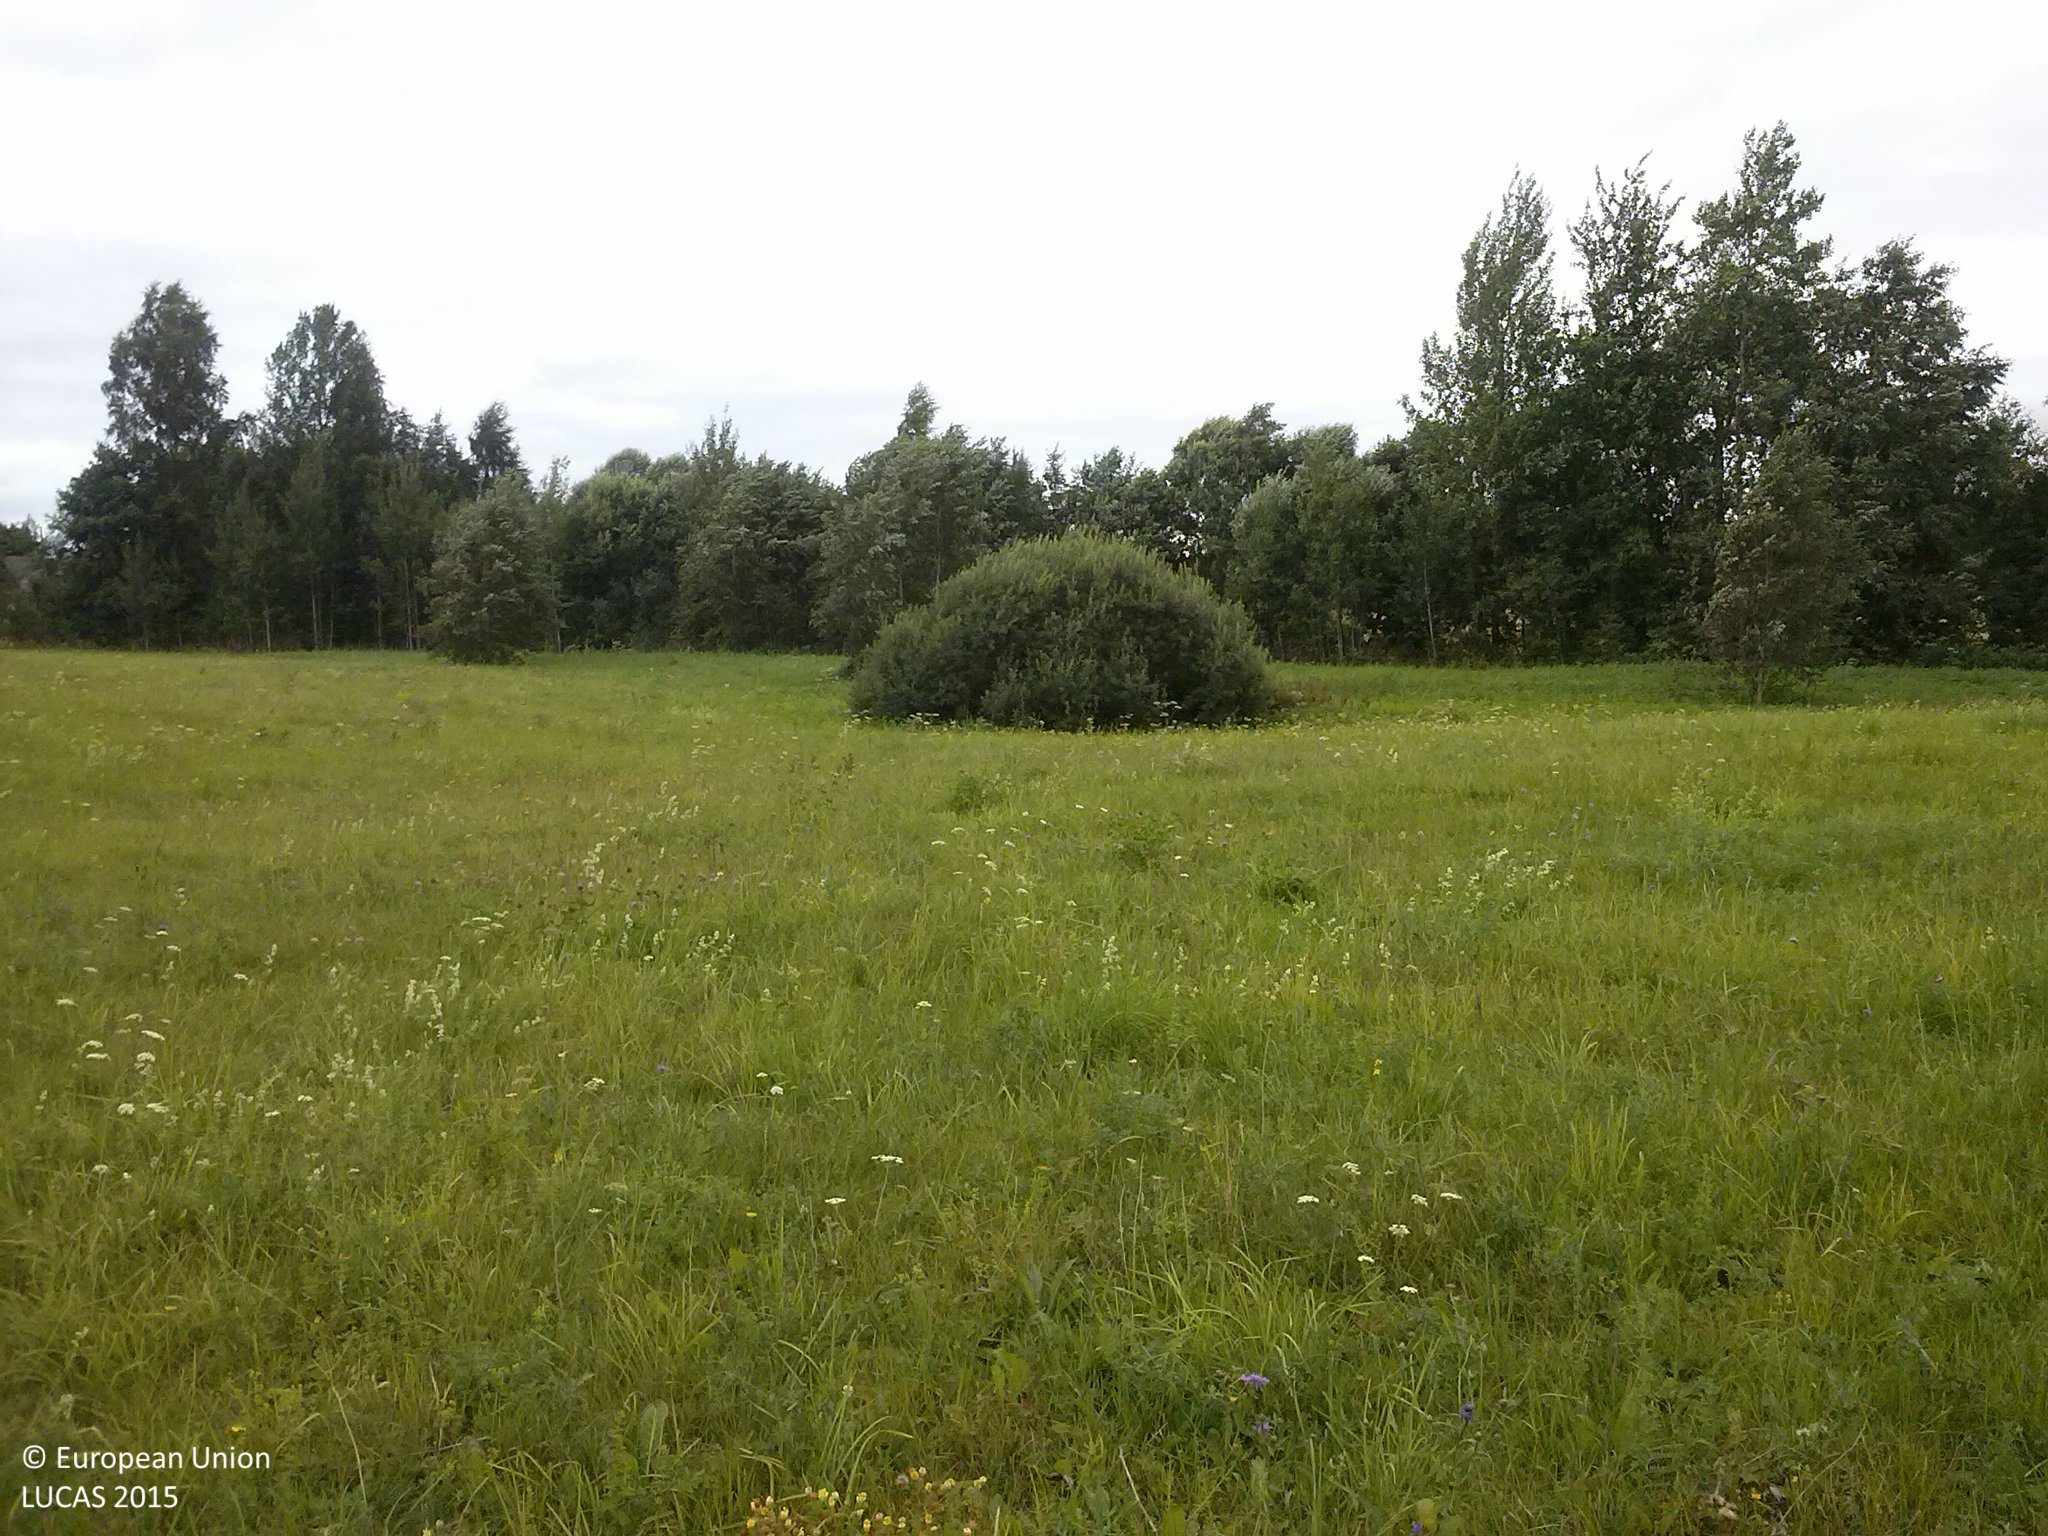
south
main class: Grassland
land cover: Grassland without tree/shrub cover
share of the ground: > 75 %
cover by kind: herbaceous plants 100 %
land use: Agriculture (excluding fallow land and kitchen gardens)
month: August
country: LV
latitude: 56.2340
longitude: 26.7571
